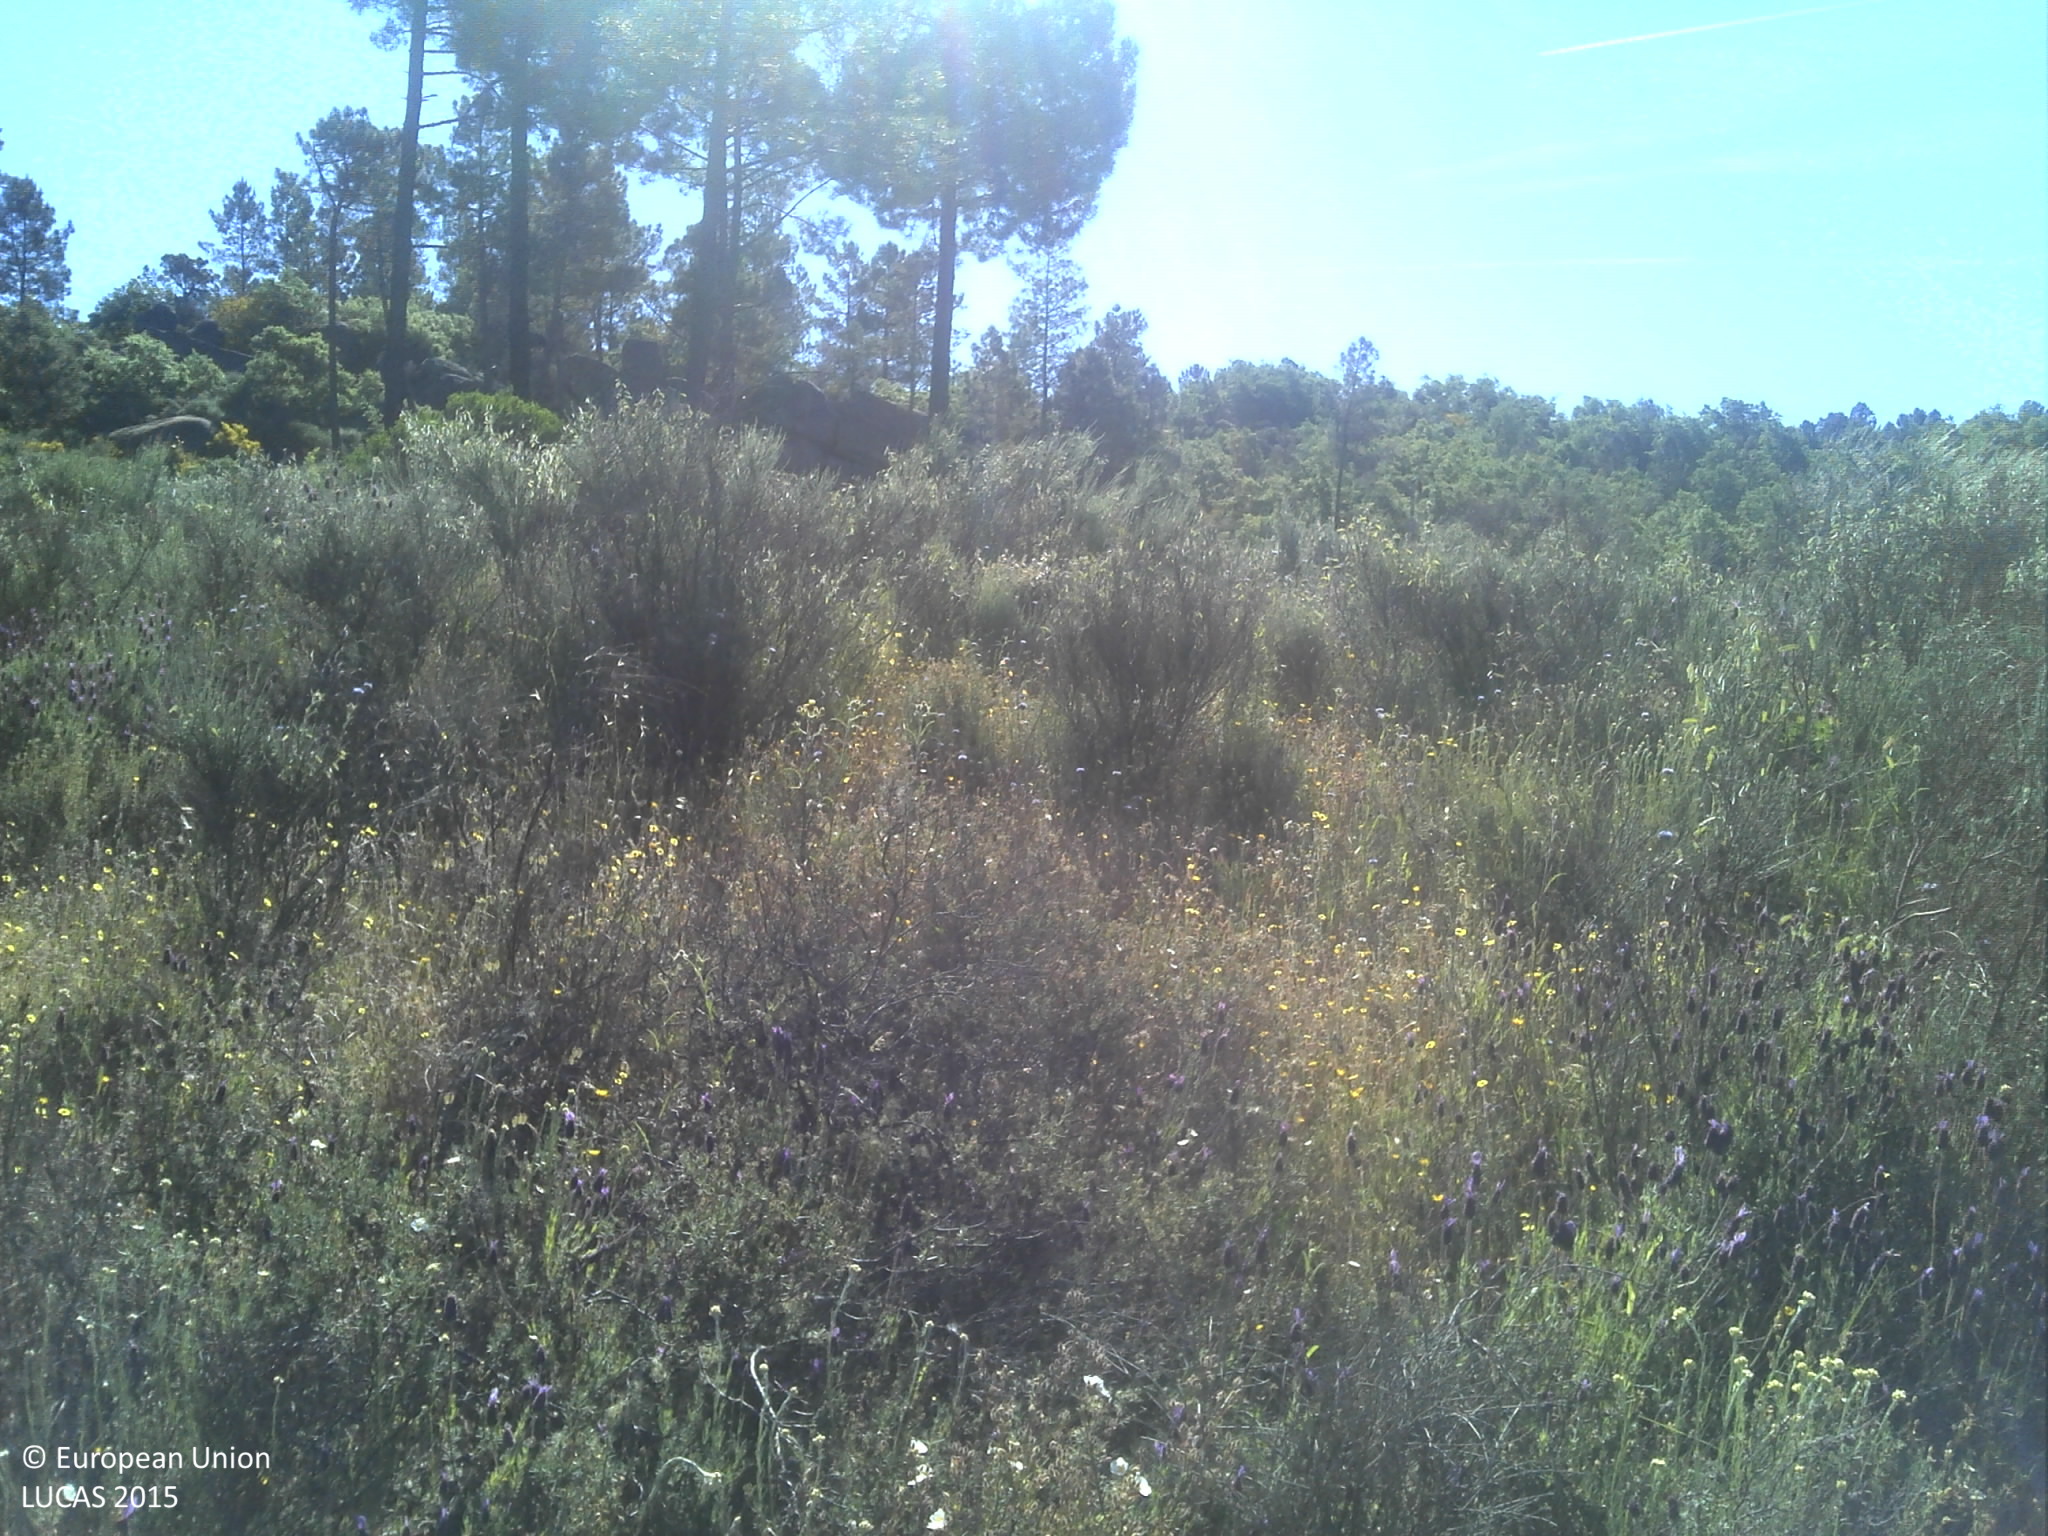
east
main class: Shrubland
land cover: Shrubland with sparse tree cover
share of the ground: 50 - 75 %
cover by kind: shrubs 80 %, herbaceous plants 15 %, broadleaved forest trees 5 %
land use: Semi-natural and natural areas not in use
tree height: > 5 m
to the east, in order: Shrubland with sparse tree cover; Tracks; Fences; Grass margins; Railways; Grass margins; Fences; Grassland without tree/shrub cover; Tracks; Pine dominated mixed woodland
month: May
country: PT
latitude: 40.7163
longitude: -7.2617
